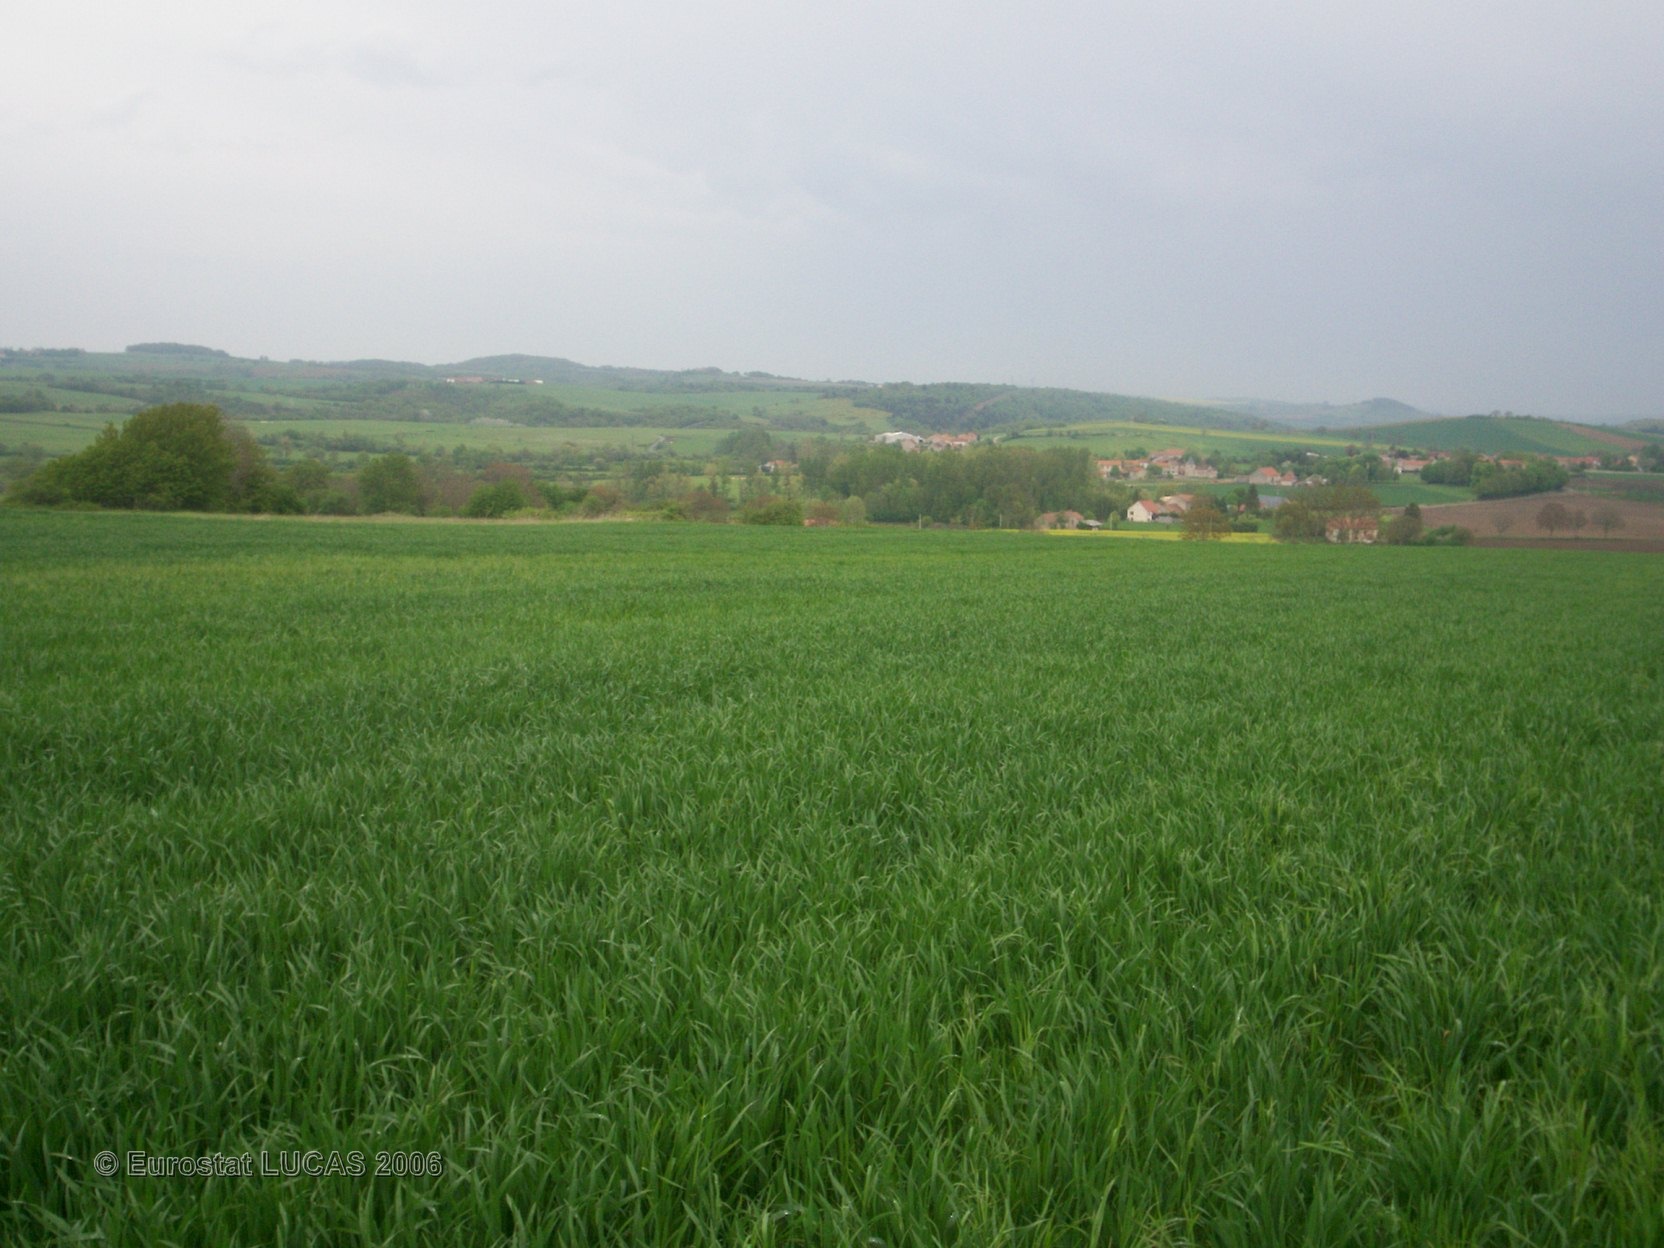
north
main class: Cropland
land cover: Common wheat
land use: Agriculture (excluding fallow land and kitchen gardens)
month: May
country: FR
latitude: 46.0599
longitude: 3.1610
